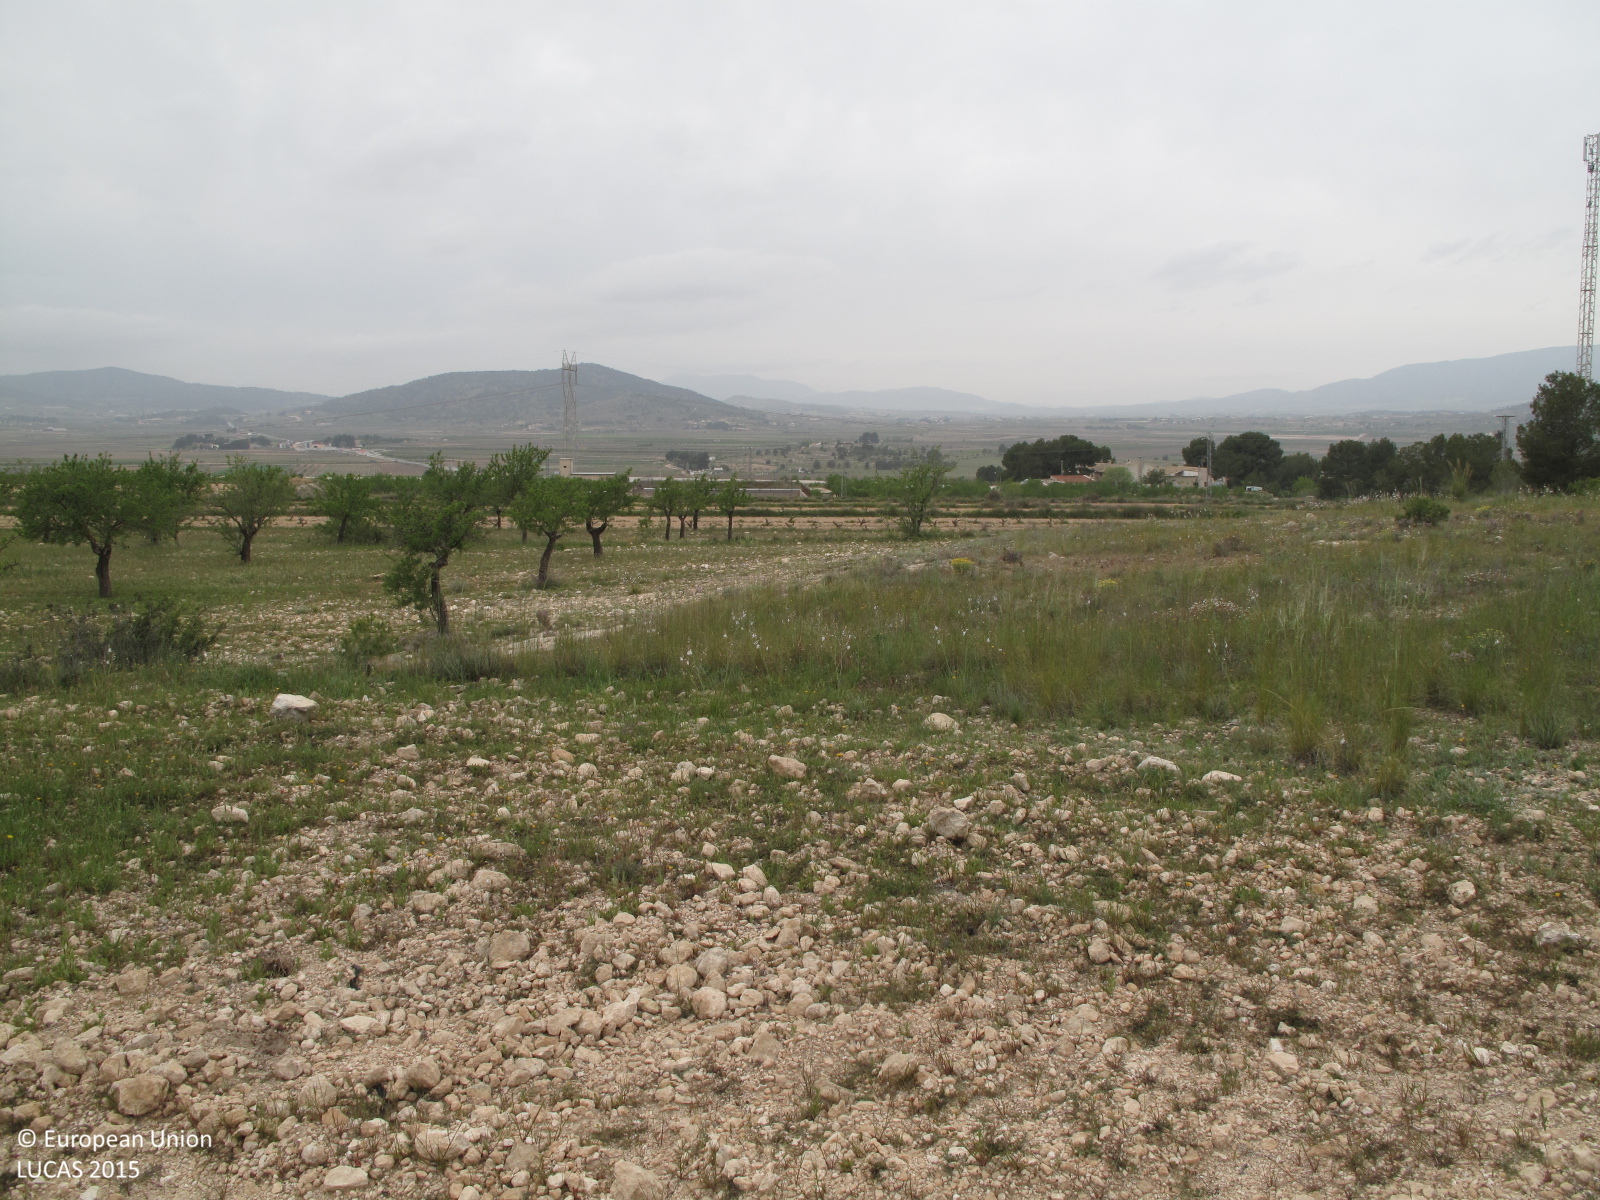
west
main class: Cropland
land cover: Nuts trees
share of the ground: < 10 %
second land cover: Spontaneously vegetated surfaces
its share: > 75 %
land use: Agriculture (excluding fallow land and kitchen gardens)
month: April
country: ES
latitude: 38.4344
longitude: -0.9057
